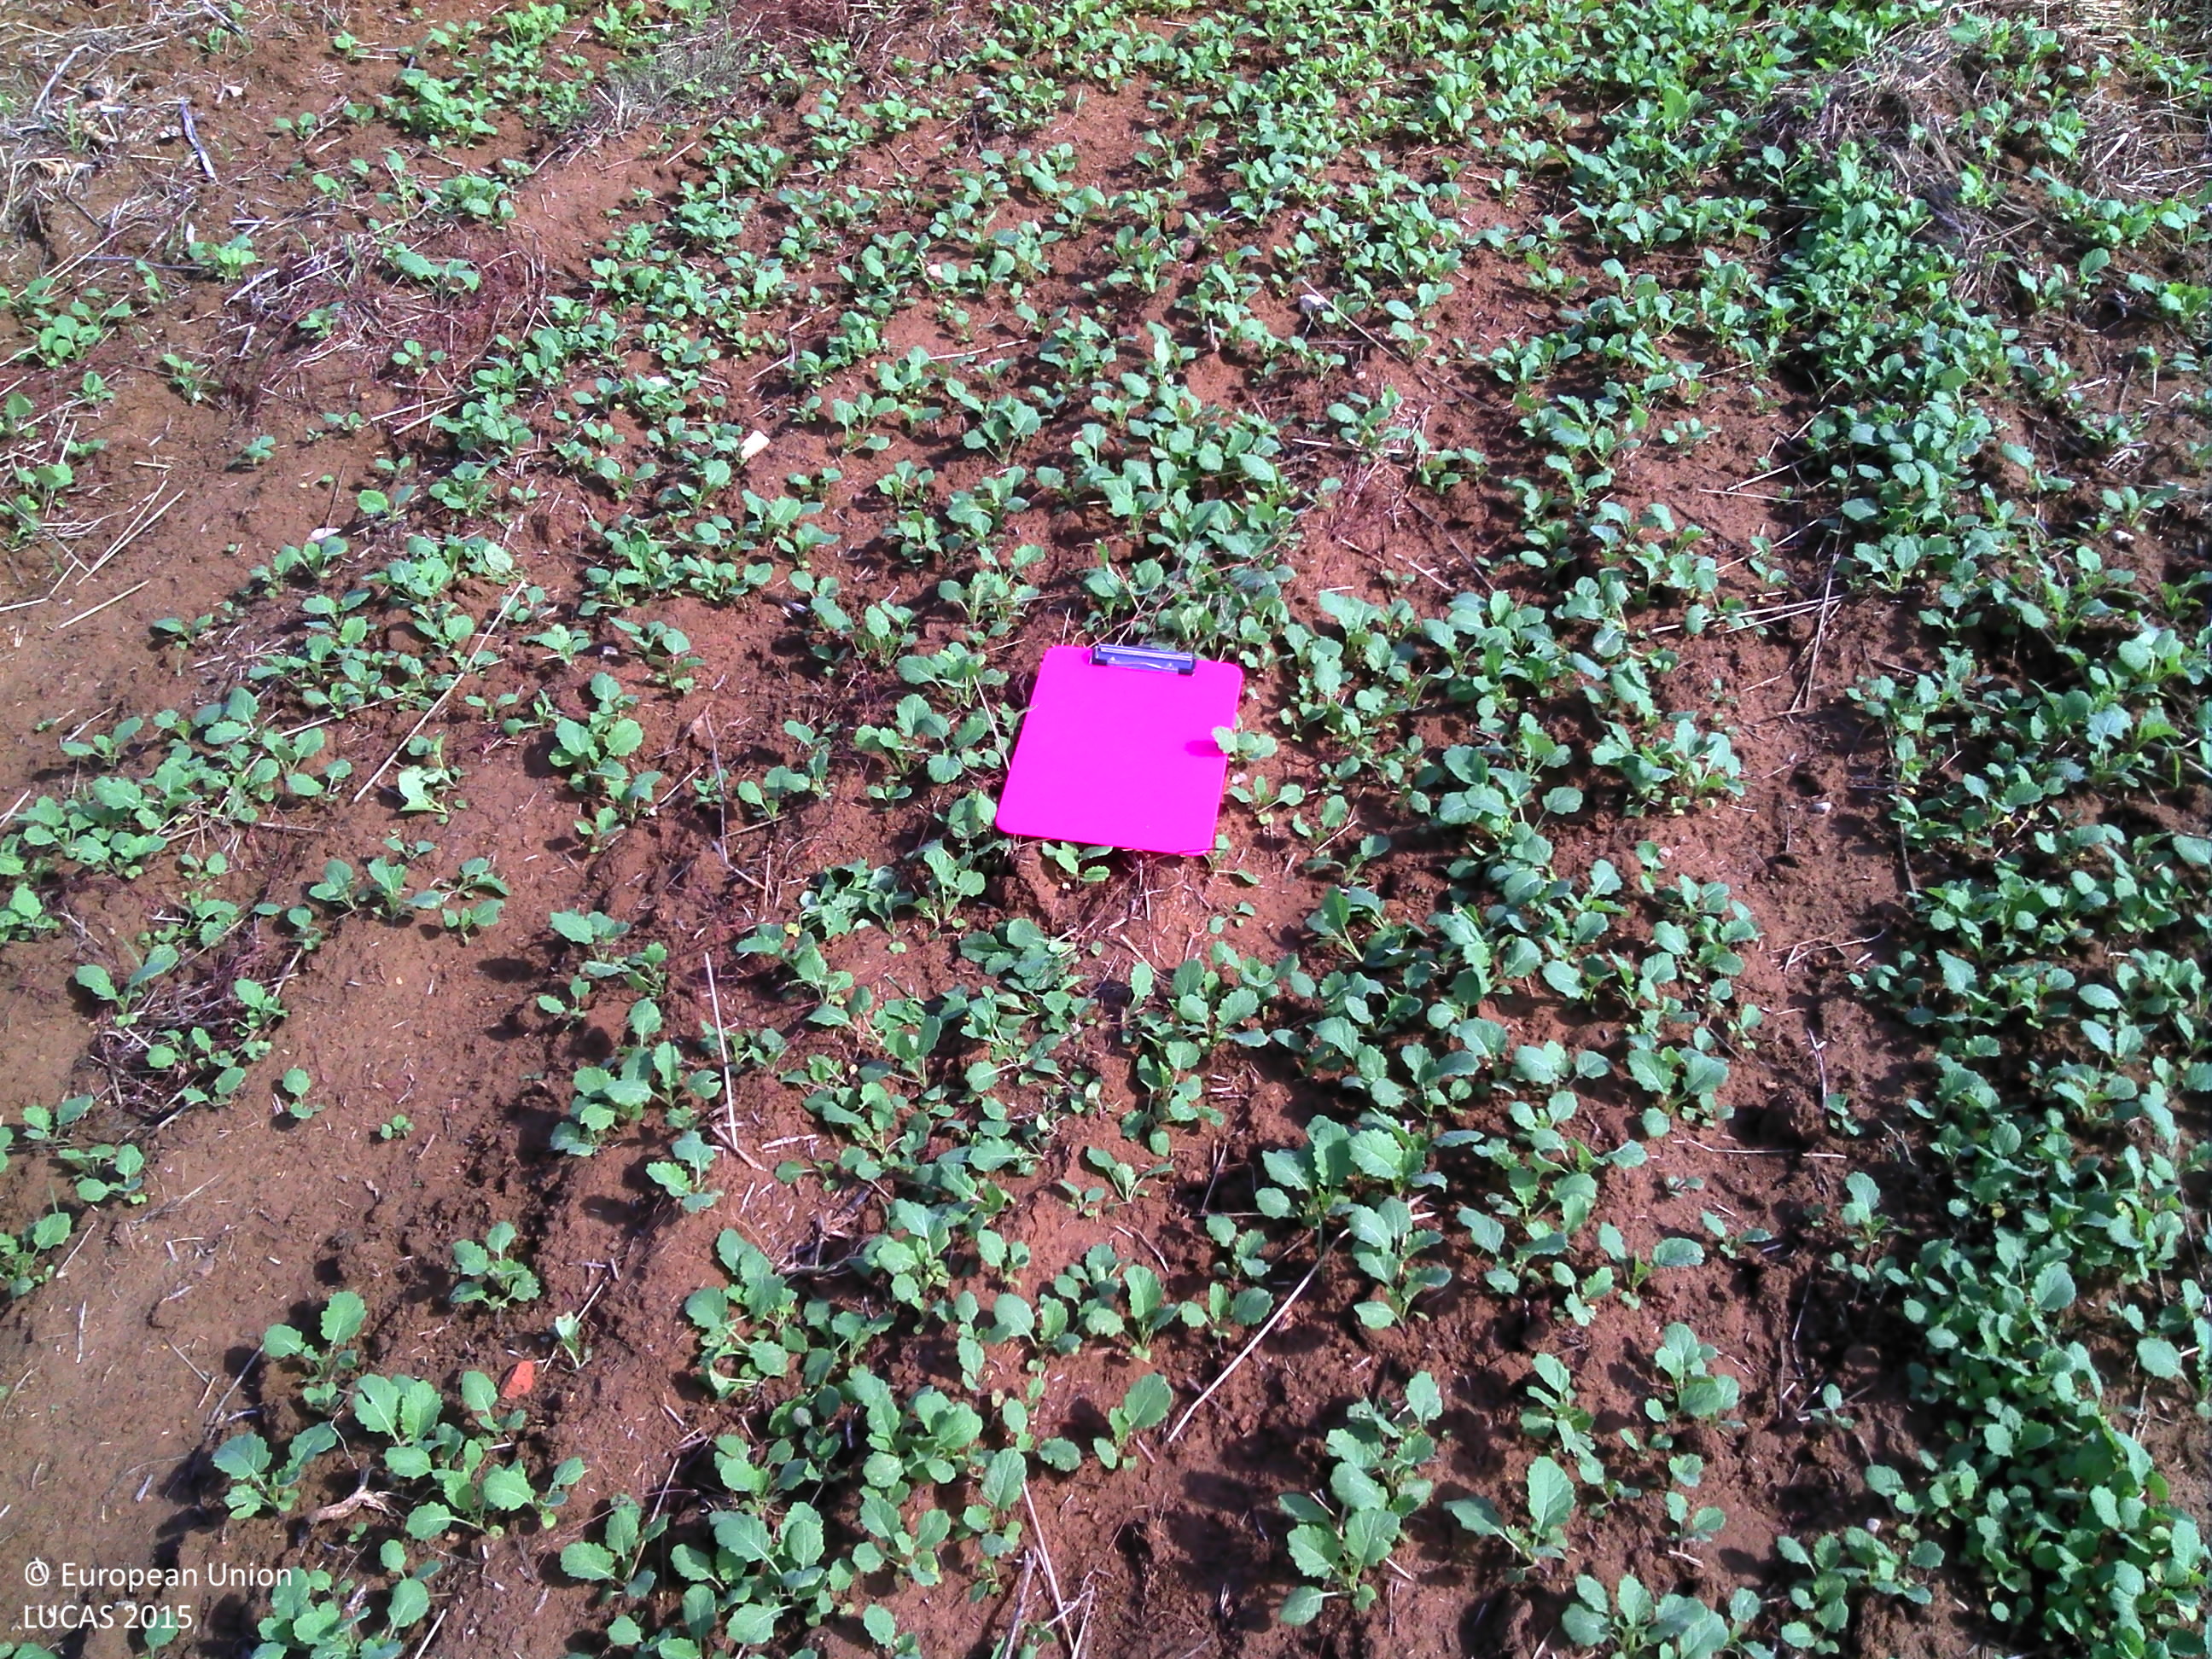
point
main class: Cropland
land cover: Rape and turnip rape
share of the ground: 10 - 25 %
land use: Agriculture (excluding fallow land and kitchen gardens)
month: September
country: FR
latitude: 48.2945
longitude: 4.7007
